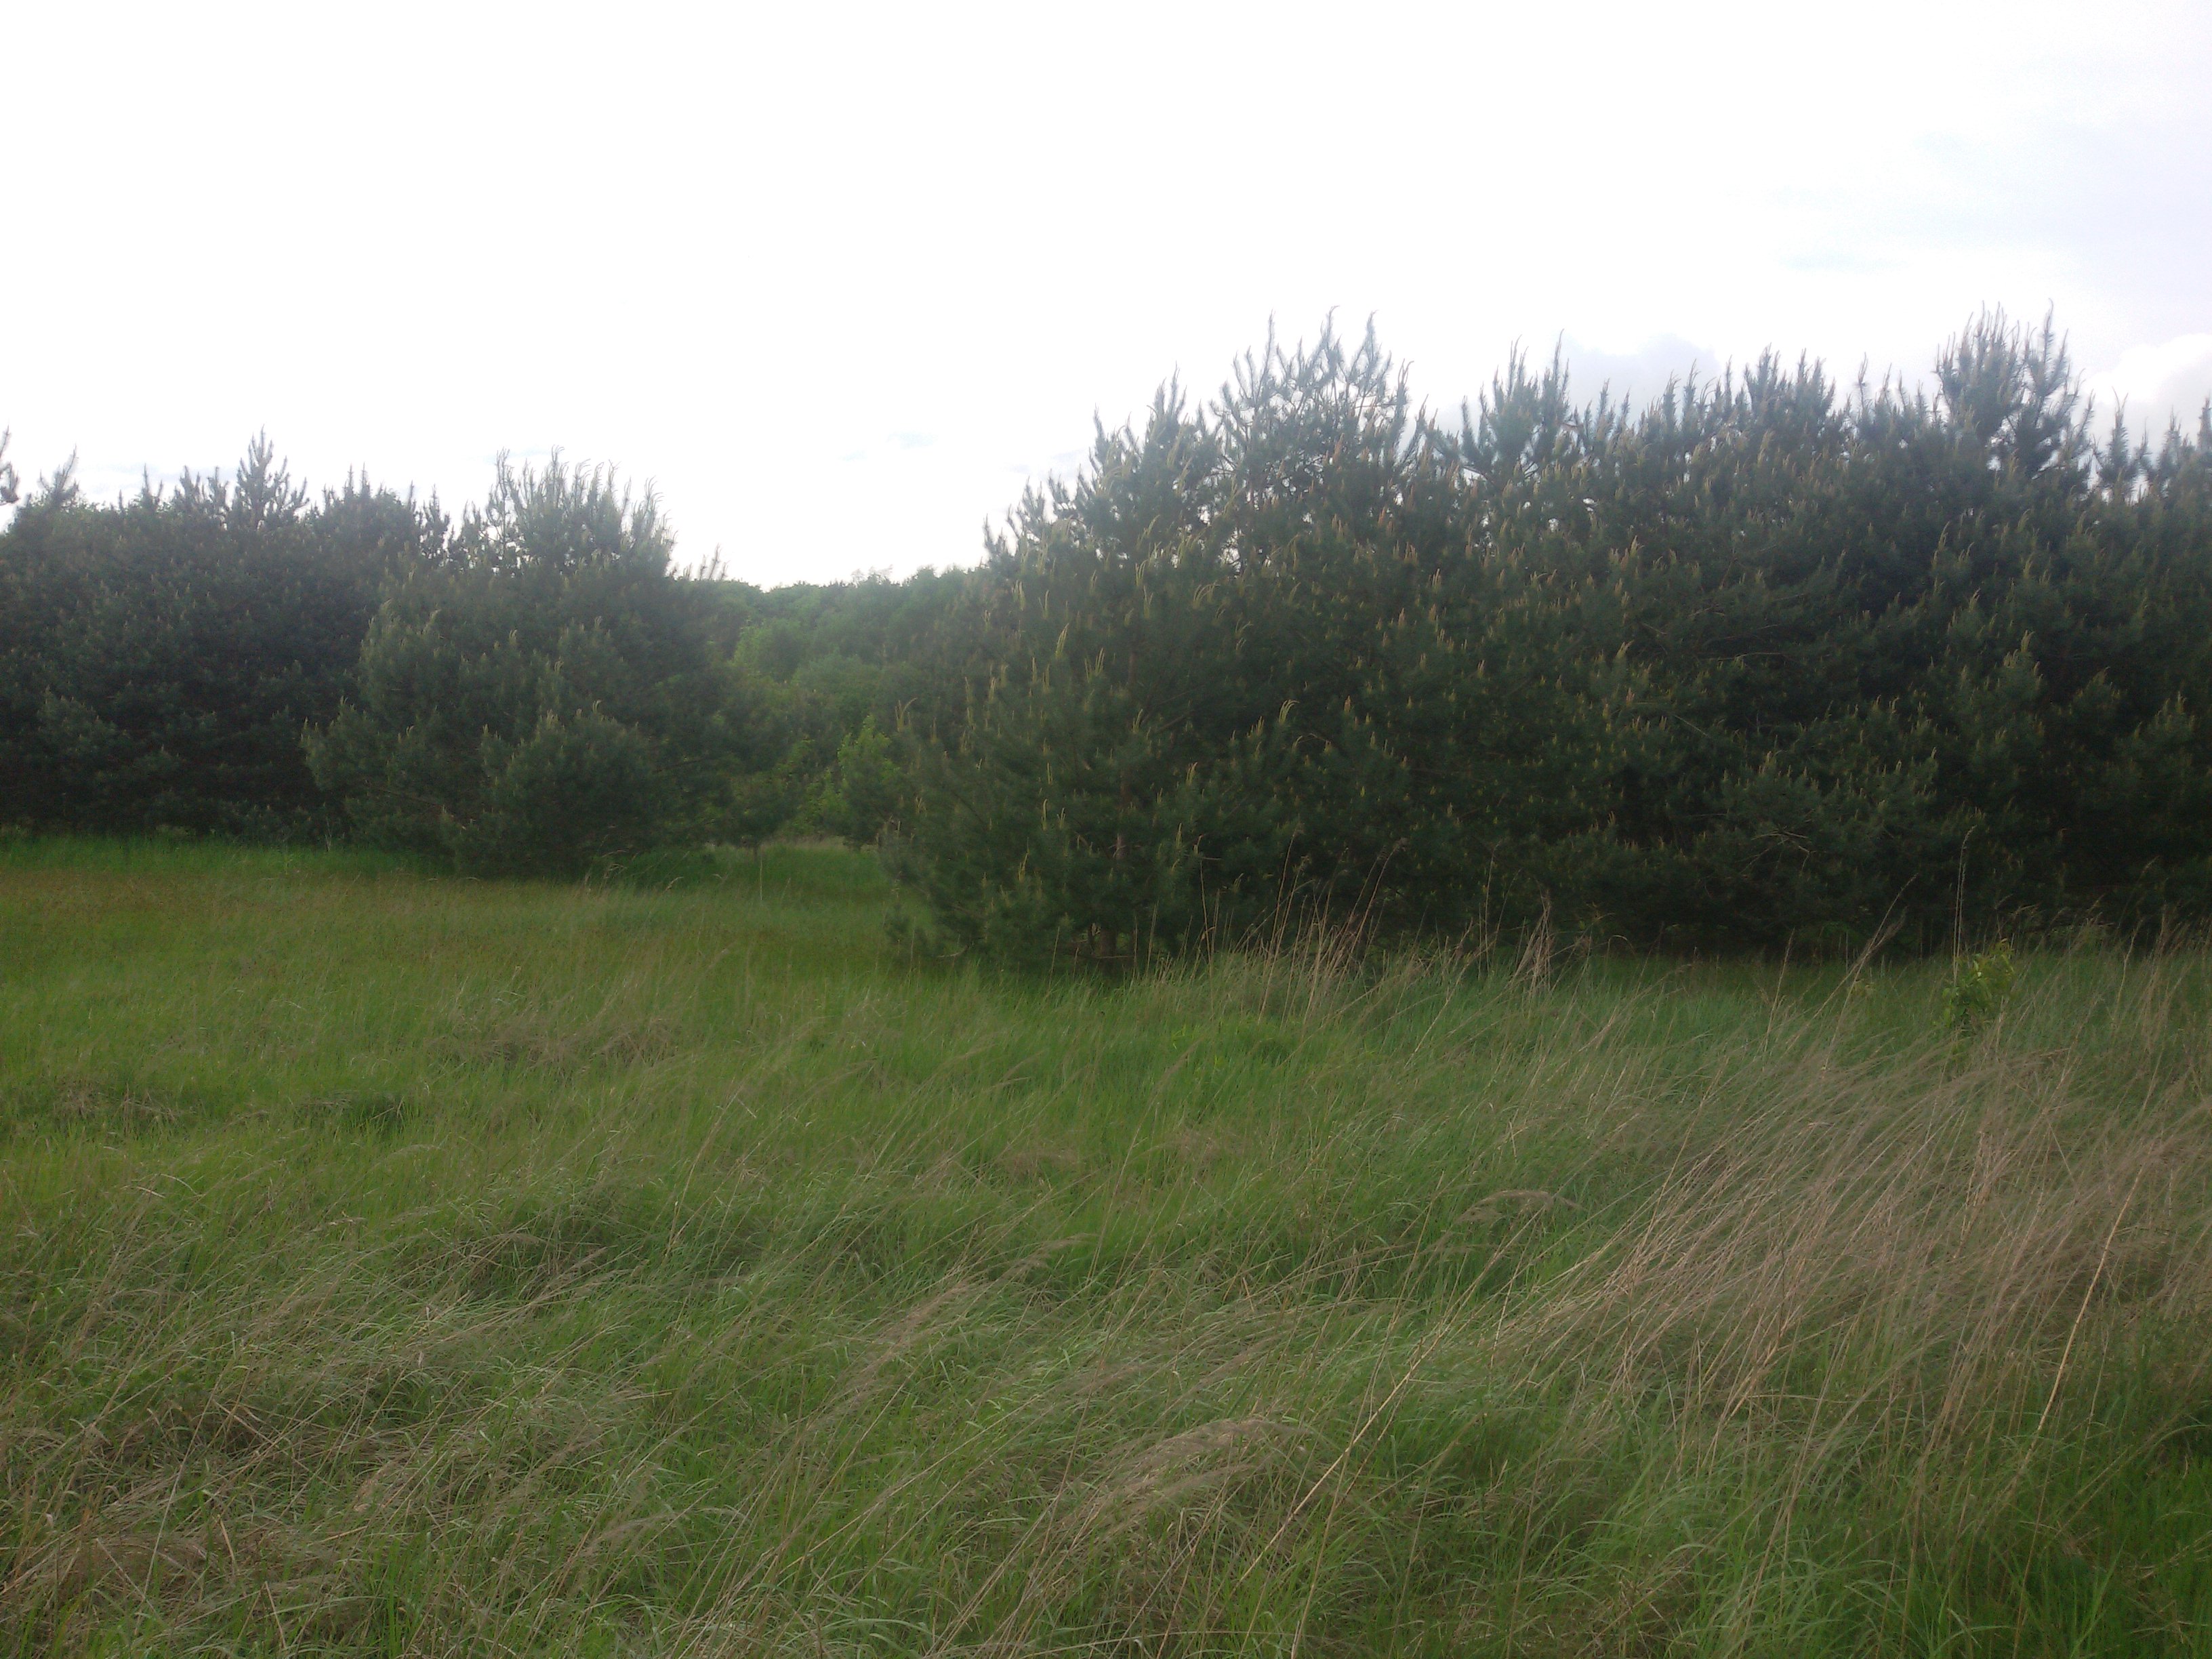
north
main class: Grassland
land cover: Grassland with sparse tree/shrub cover
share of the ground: > 75 %
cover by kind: herbaceous plants 95 %, coniferous forest trees 5 %
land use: Semi-natural and natural areas not in use
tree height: < 5 m
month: May
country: PL
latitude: 53.5160
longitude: 14.5103
